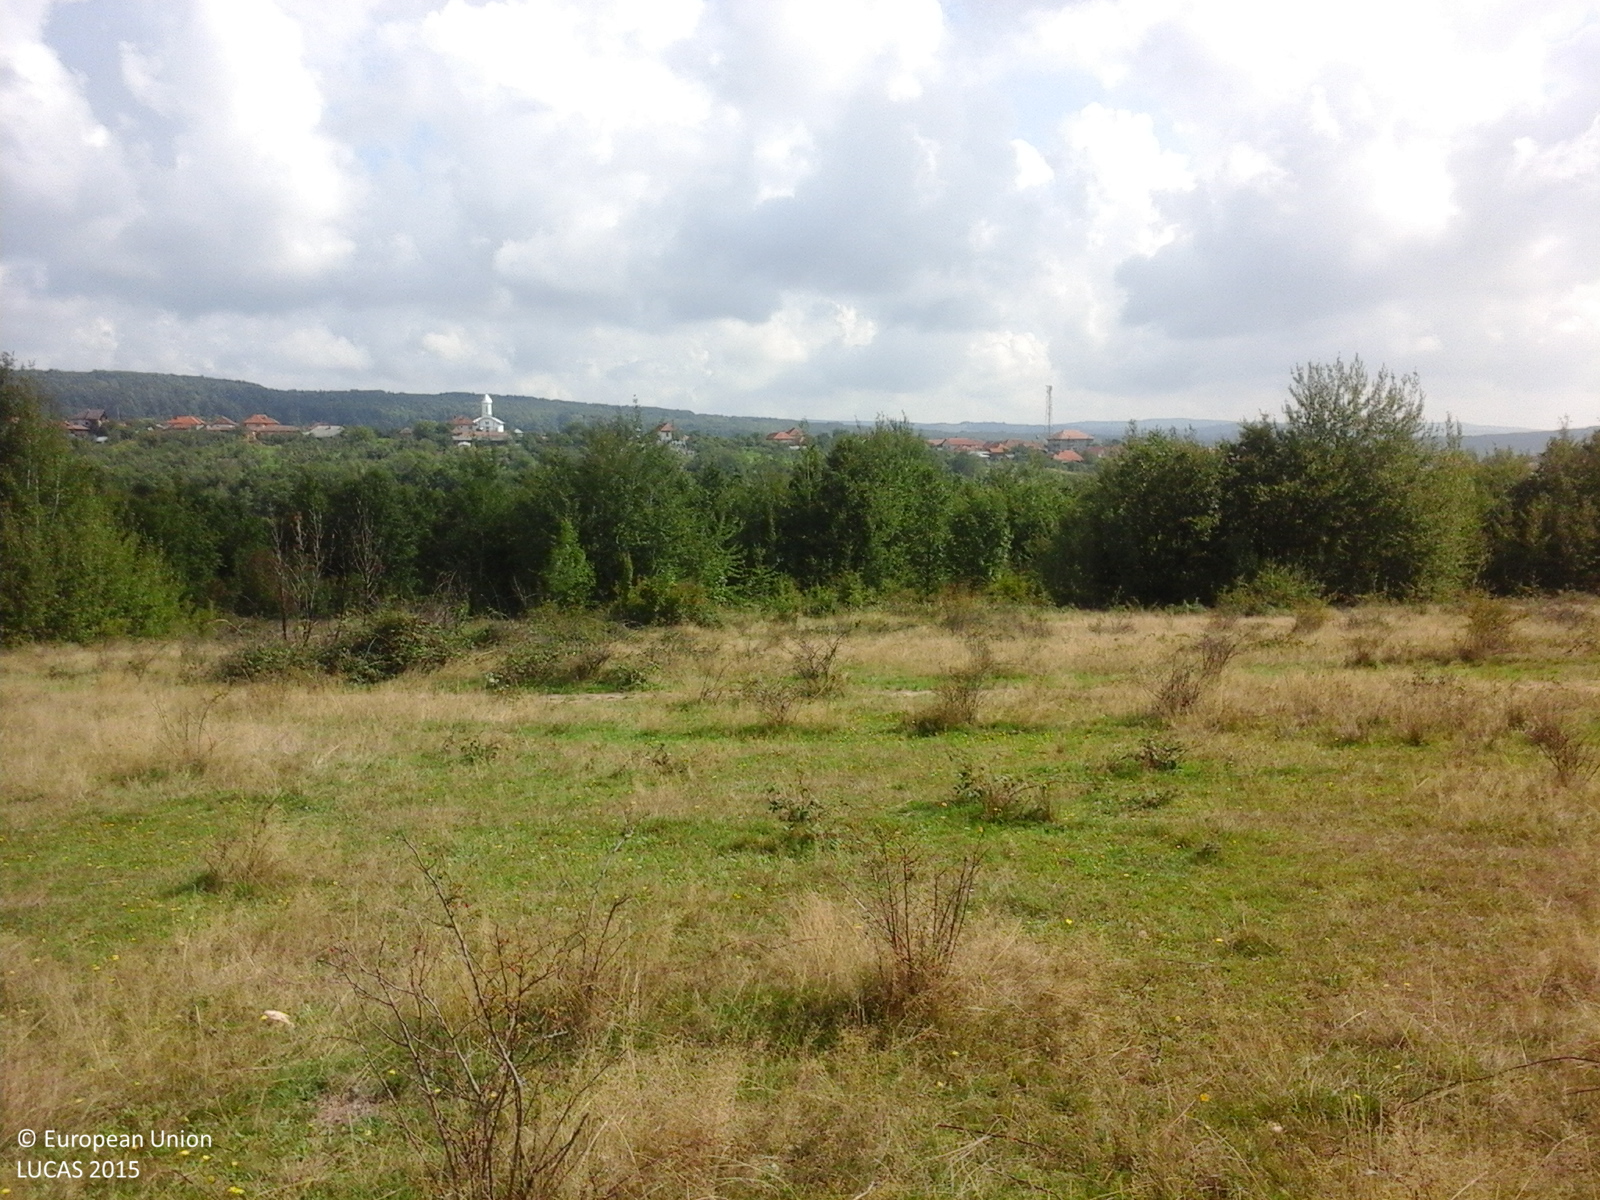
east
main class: Grassland
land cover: Grassland with sparse tree/shrub cover
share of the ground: > 75 %
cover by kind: herbaceous plants 95 %, broadleaved forest trees 5 %
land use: Agriculture (excluding fallow land and kitchen gardens)
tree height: > 5 m
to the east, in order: Grassland with sparse tree/shrub cover; Broadleaved woodland; Rivers and streams; Broadleaved woodland; Grassland without tree/shrub cover
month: September
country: RO
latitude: 45.1502
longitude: 23.4509
